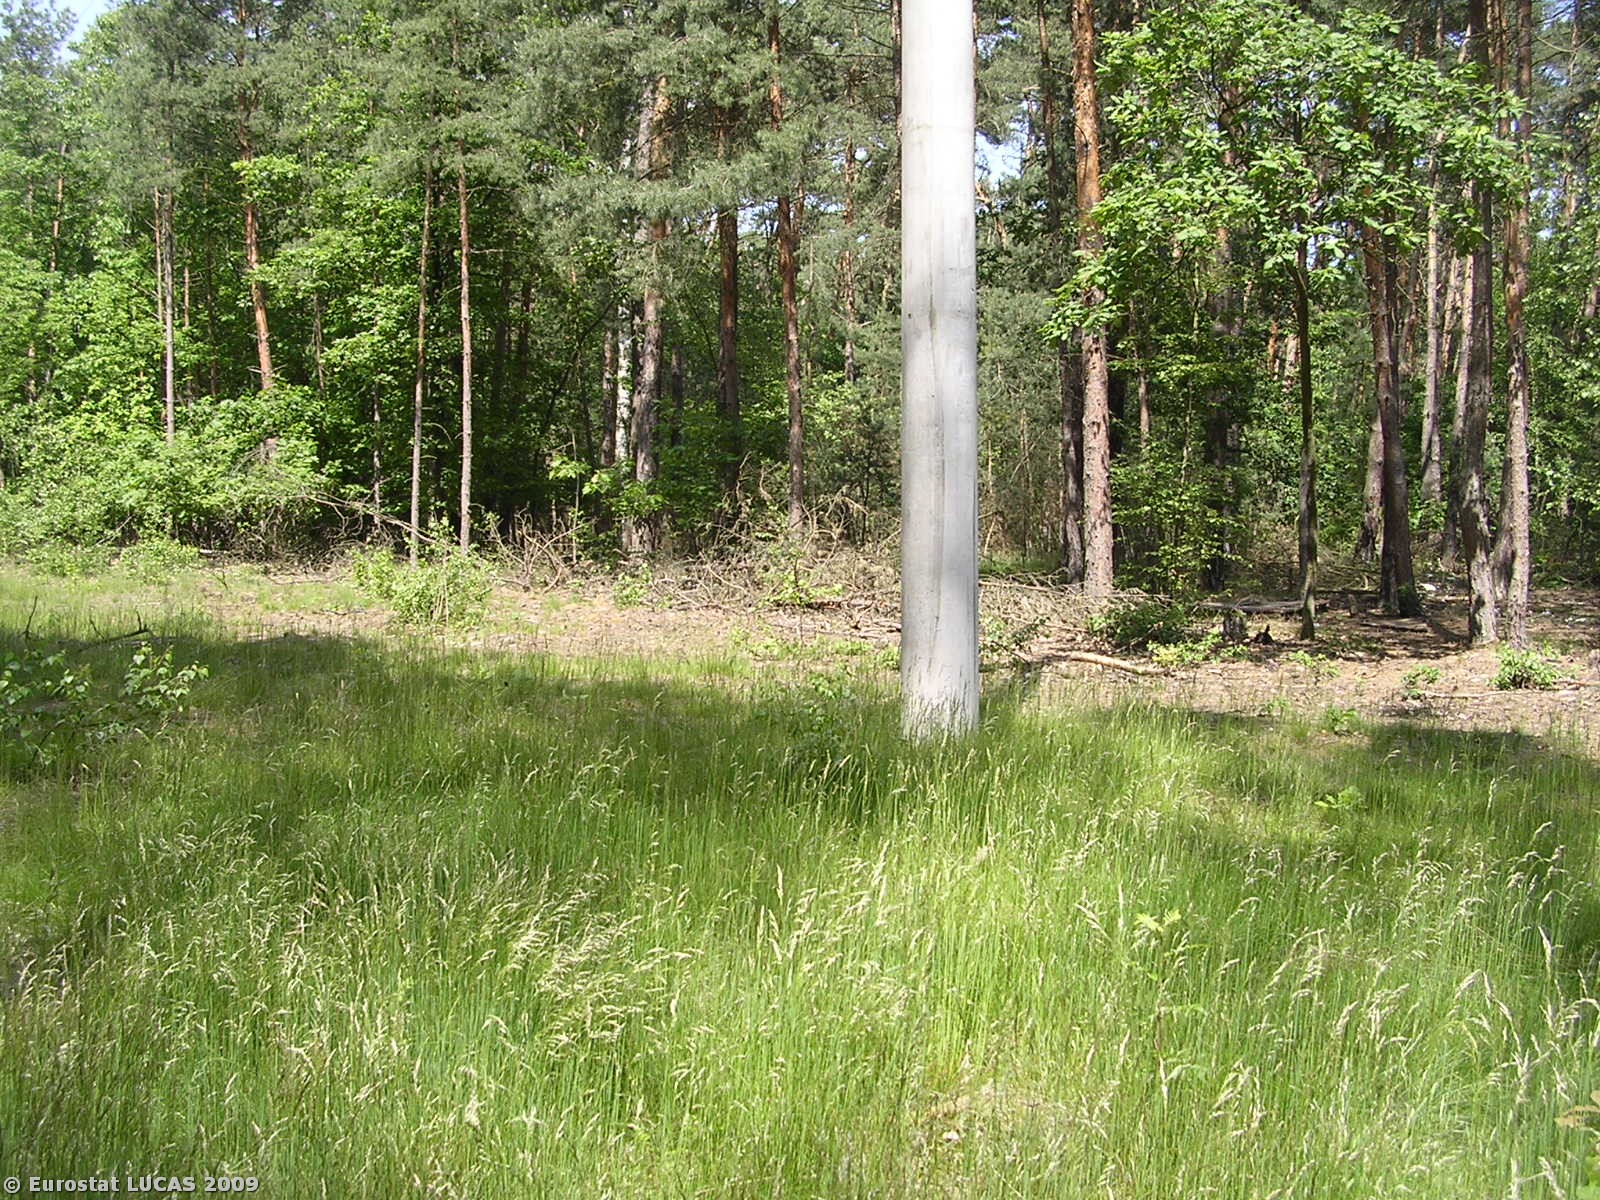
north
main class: Grassland
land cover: Grassland with sparse tree/shrub cover
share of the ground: > 75 %
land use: Forestry
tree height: > 5 m
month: May
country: CZ
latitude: 50.2315
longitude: 14.6984
